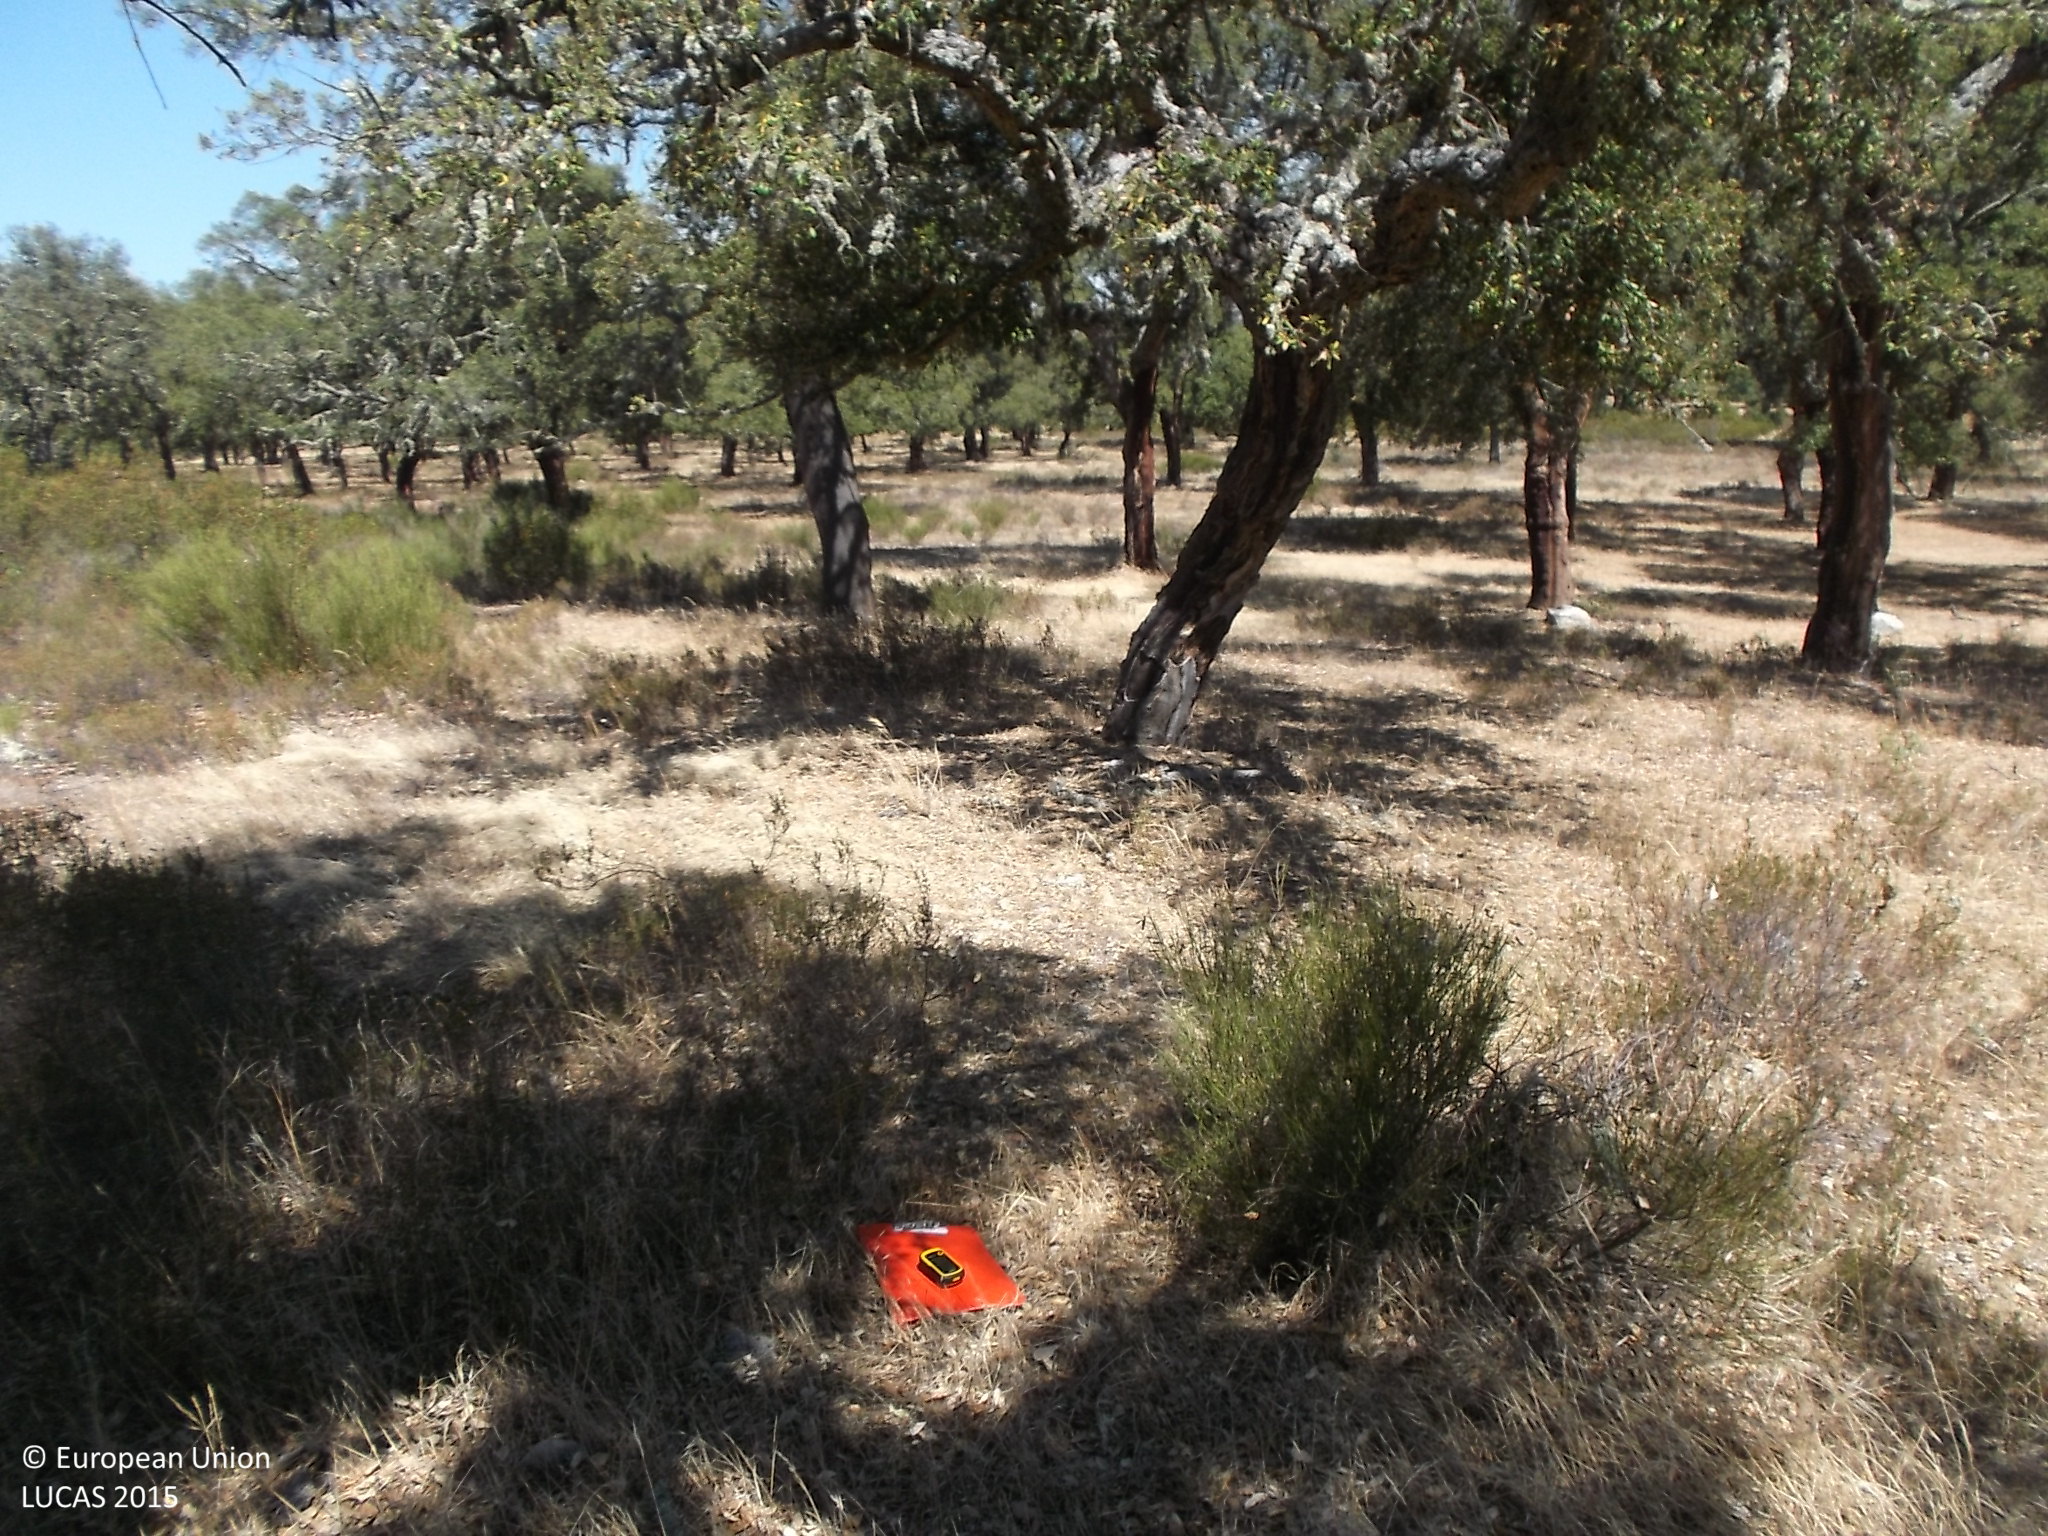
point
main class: Woodland
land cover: Broadleaved woodland
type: broadleaved evergreen forest
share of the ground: 25 - 50 %
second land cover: Shrubland without tree cover
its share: 25 - 50 %
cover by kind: broadleaved forest trees 50 %, shrubs 30 %, herbaceous plants 20 %
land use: Forestry
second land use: Agriculture (excluding fallow land and kitchen gardens)
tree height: < 5 m
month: July
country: ES
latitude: 41.3242
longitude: -5.8443
